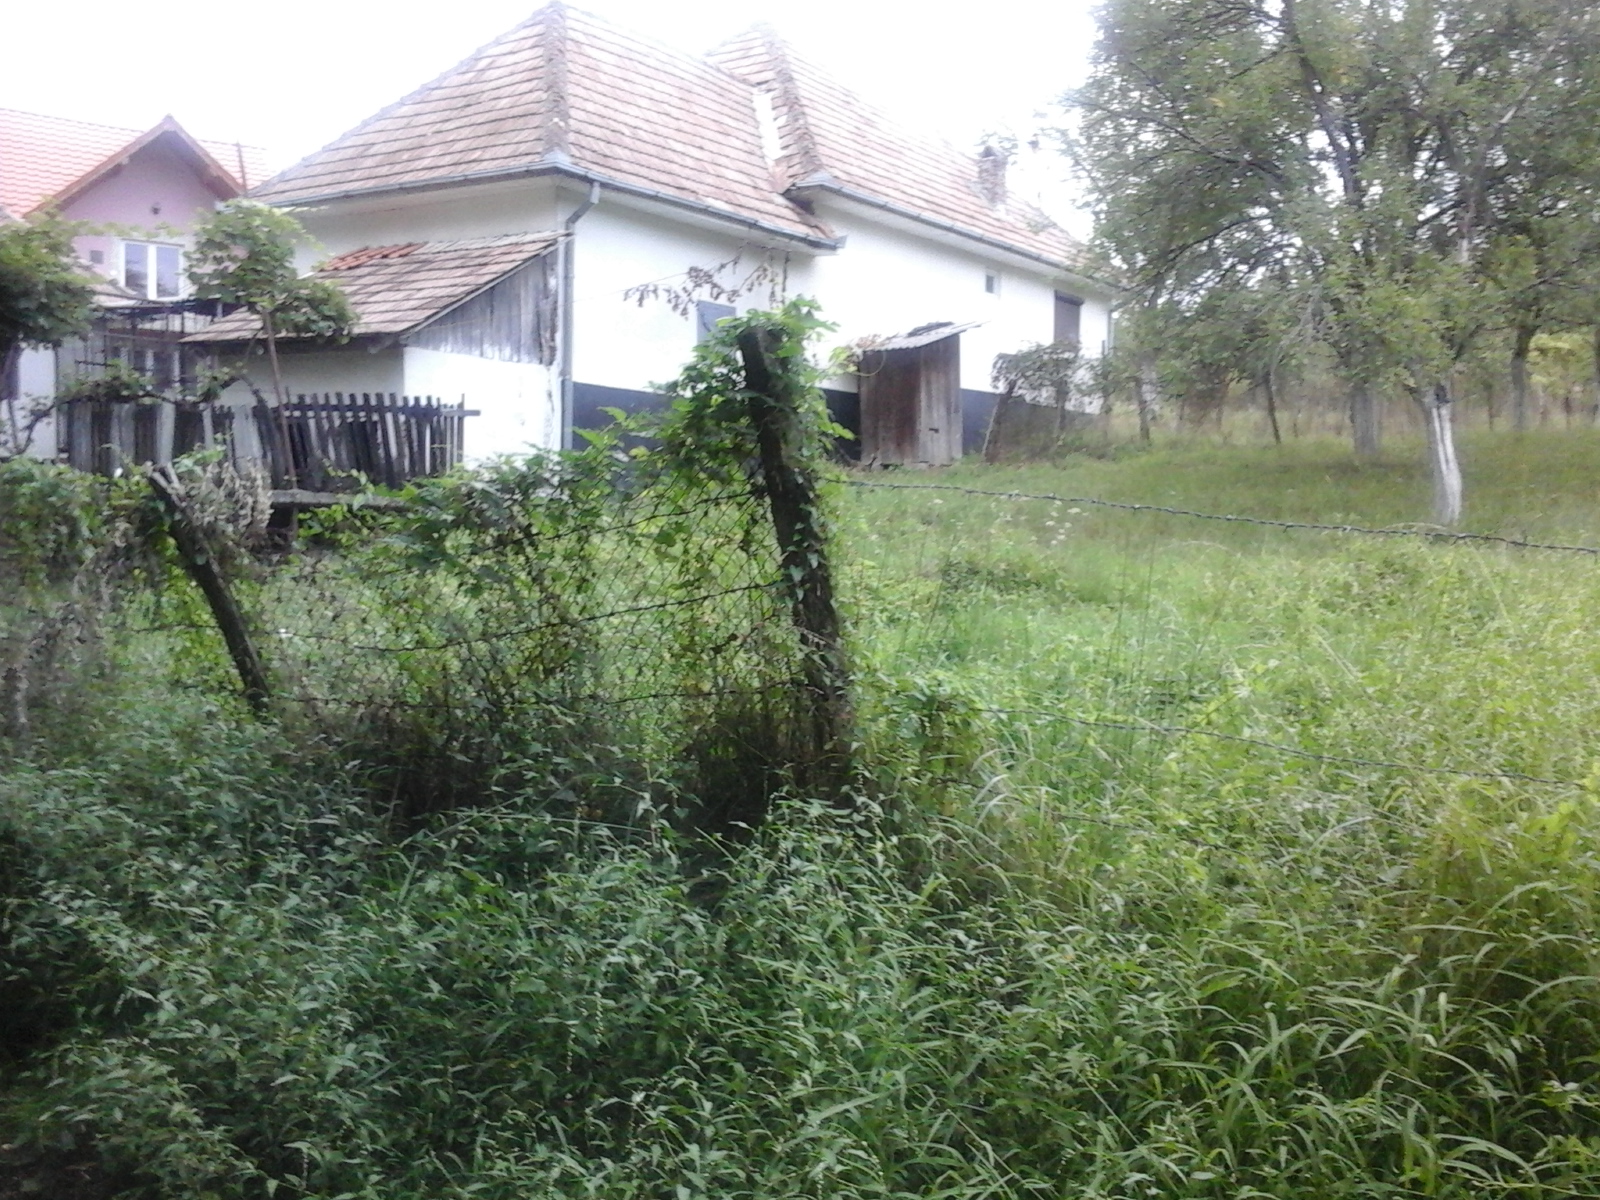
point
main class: Grassland
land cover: Grassland without tree/shrub cover
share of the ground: > 75 %
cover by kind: herbaceous plants 100 %
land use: Agriculture (excluding fallow land and kitchen gardens)
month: September
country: RO
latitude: 47.9710
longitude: 23.2119
